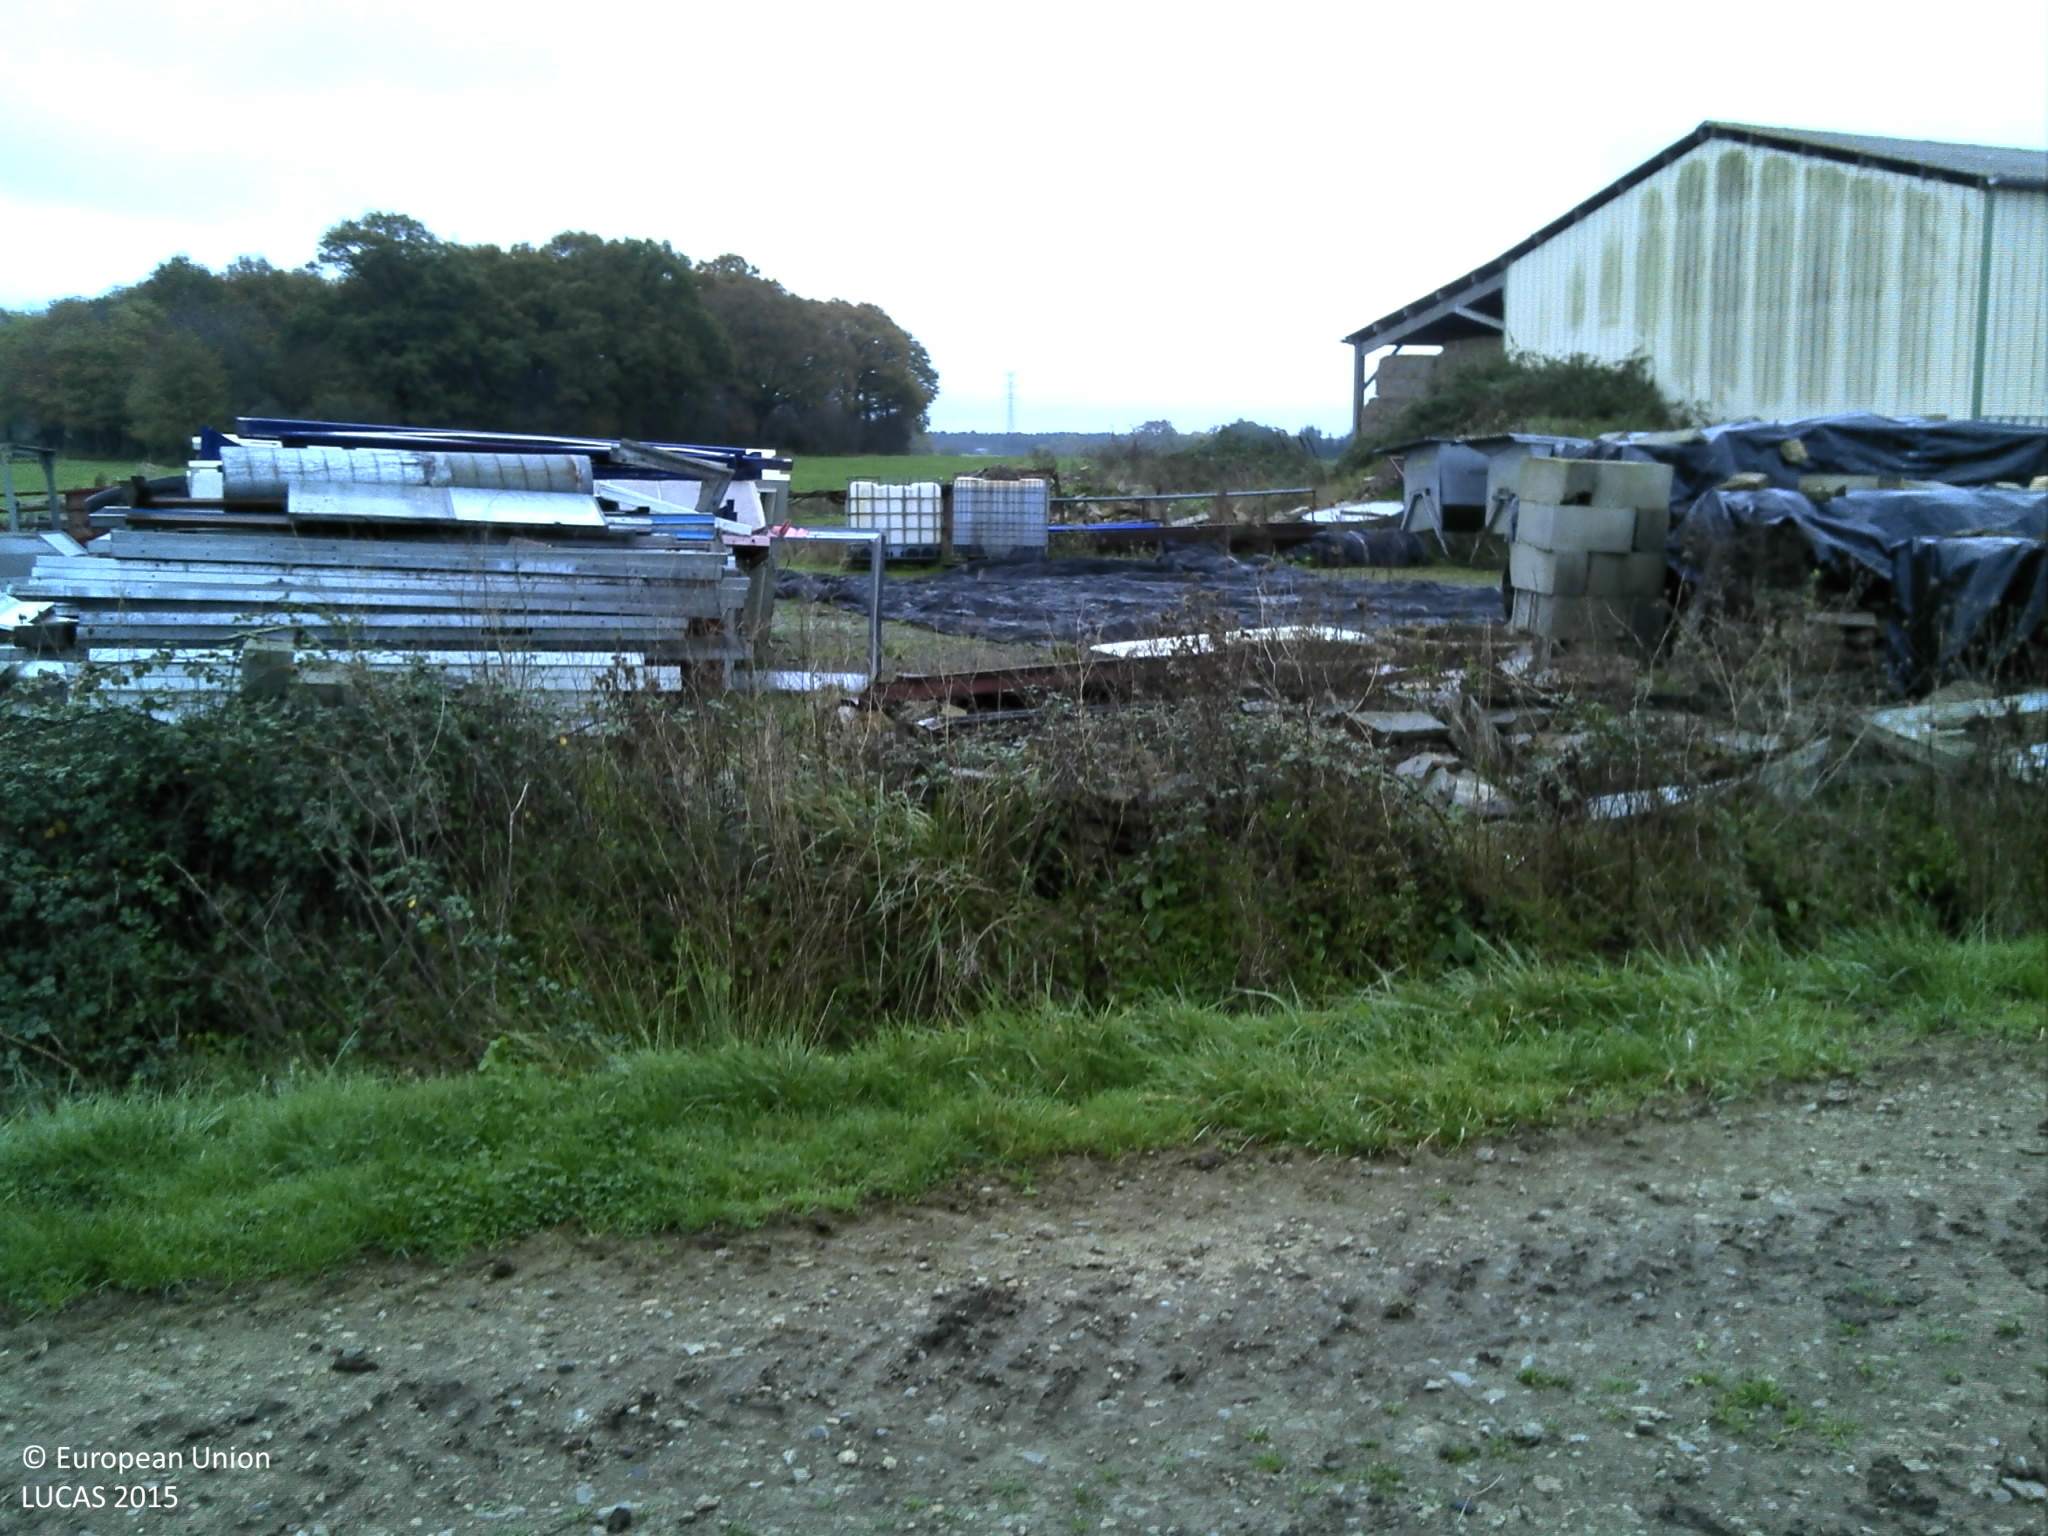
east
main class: Grassland
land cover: Grassland without tree/shrub cover
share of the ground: > 75 %
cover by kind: herbaceous plants 100 %
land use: Agriculture (excluding fallow land and kitchen gardens)
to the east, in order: Grassland without tree/shrub cover; Fences; Ditches and canals; Artificial constructions in urban areas; Grassland without tree/shrub cover; Fences; Rivers and streams; Fences; Grassland without tree/shrub cover; Fences; Broadleaved woodland
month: November
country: FR
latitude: 47.6867
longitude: -1.3795
